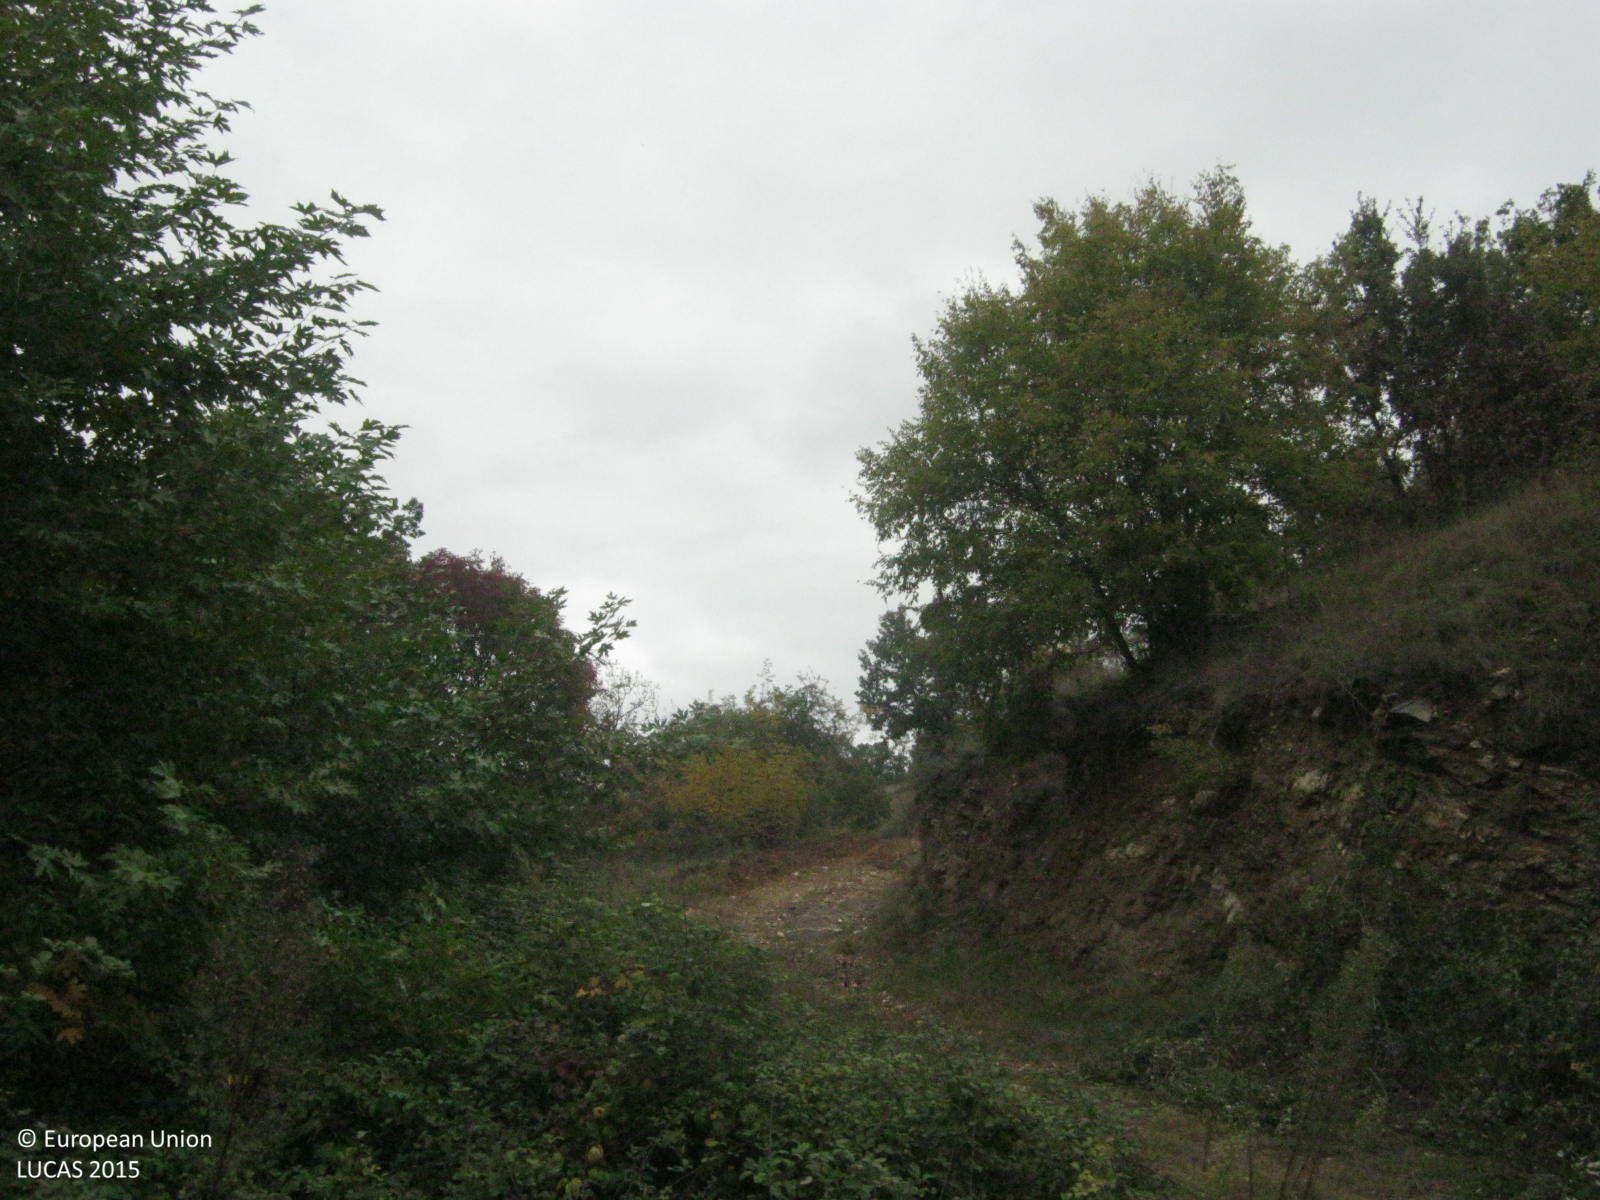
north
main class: Woodland
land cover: Broadleaved woodland
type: thermophilous deciduous forest
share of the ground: 50 - 75 %
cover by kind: broadleaved forest trees 55 %, herbaceous plants 25 %, unconsolidated bare surface 15 %, shrubs 5 %
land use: Semi-natural and natural areas not in use
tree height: > 5 m
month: October
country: GR
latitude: 41.0605
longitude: 23.0189
